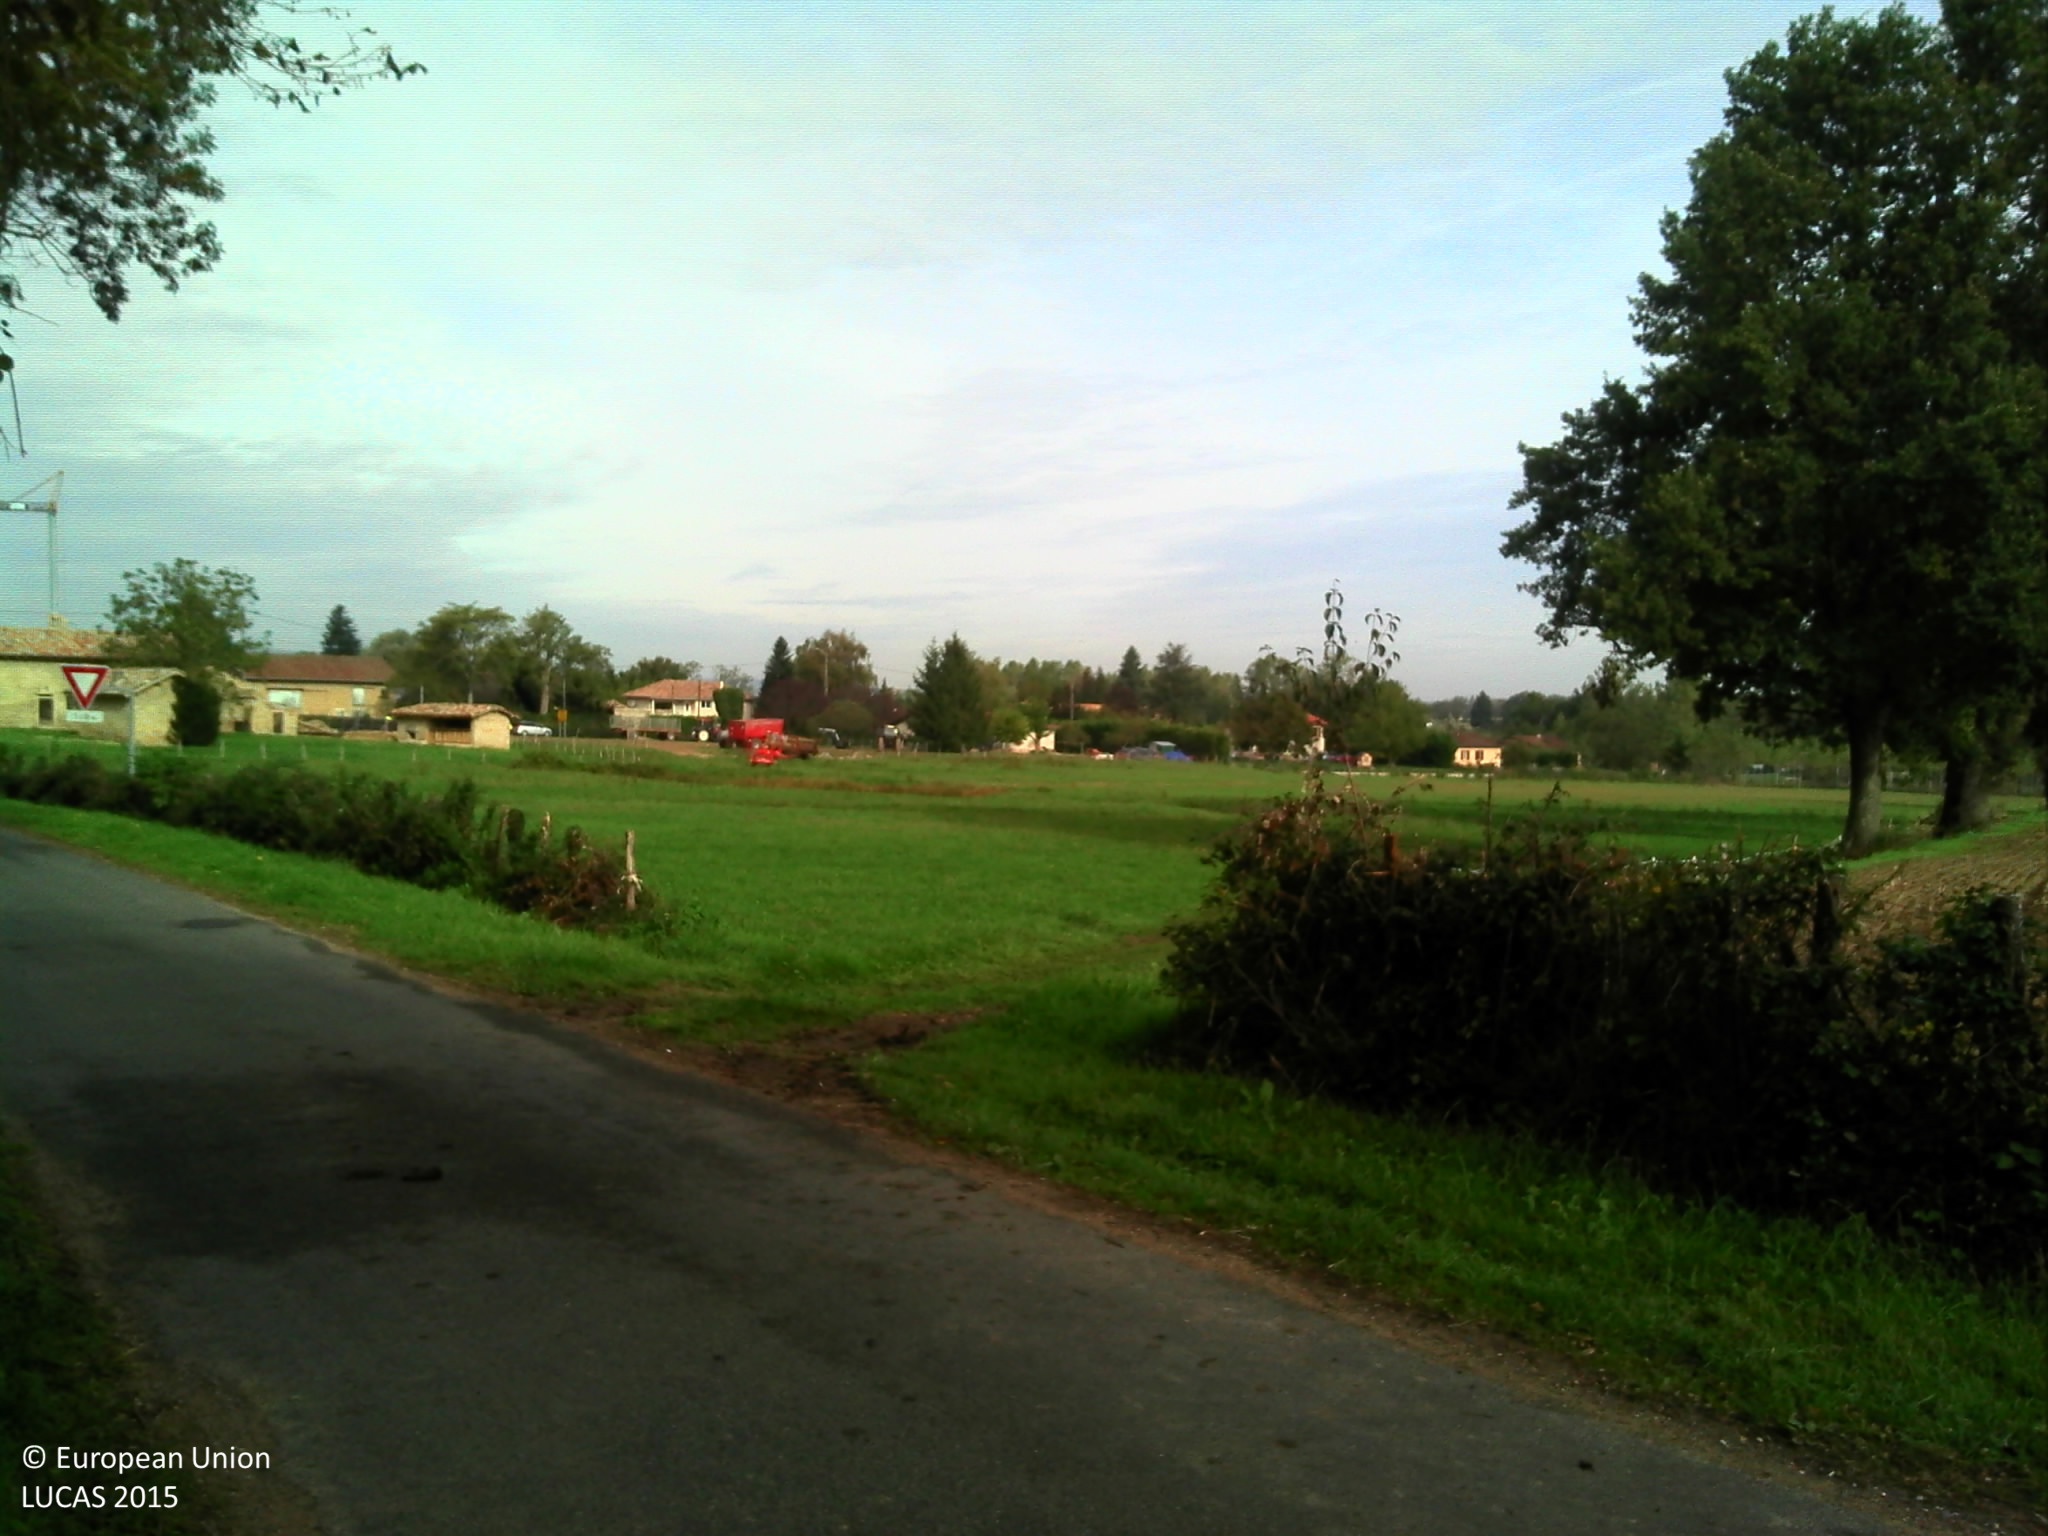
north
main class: Grassland
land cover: Grassland with sparse tree/shrub cover
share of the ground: > 75 %
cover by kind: herbaceous plants 95 %, broadleaved forest trees 5 %
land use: Residential
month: October
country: FR
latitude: 46.3928
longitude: 4.9174
